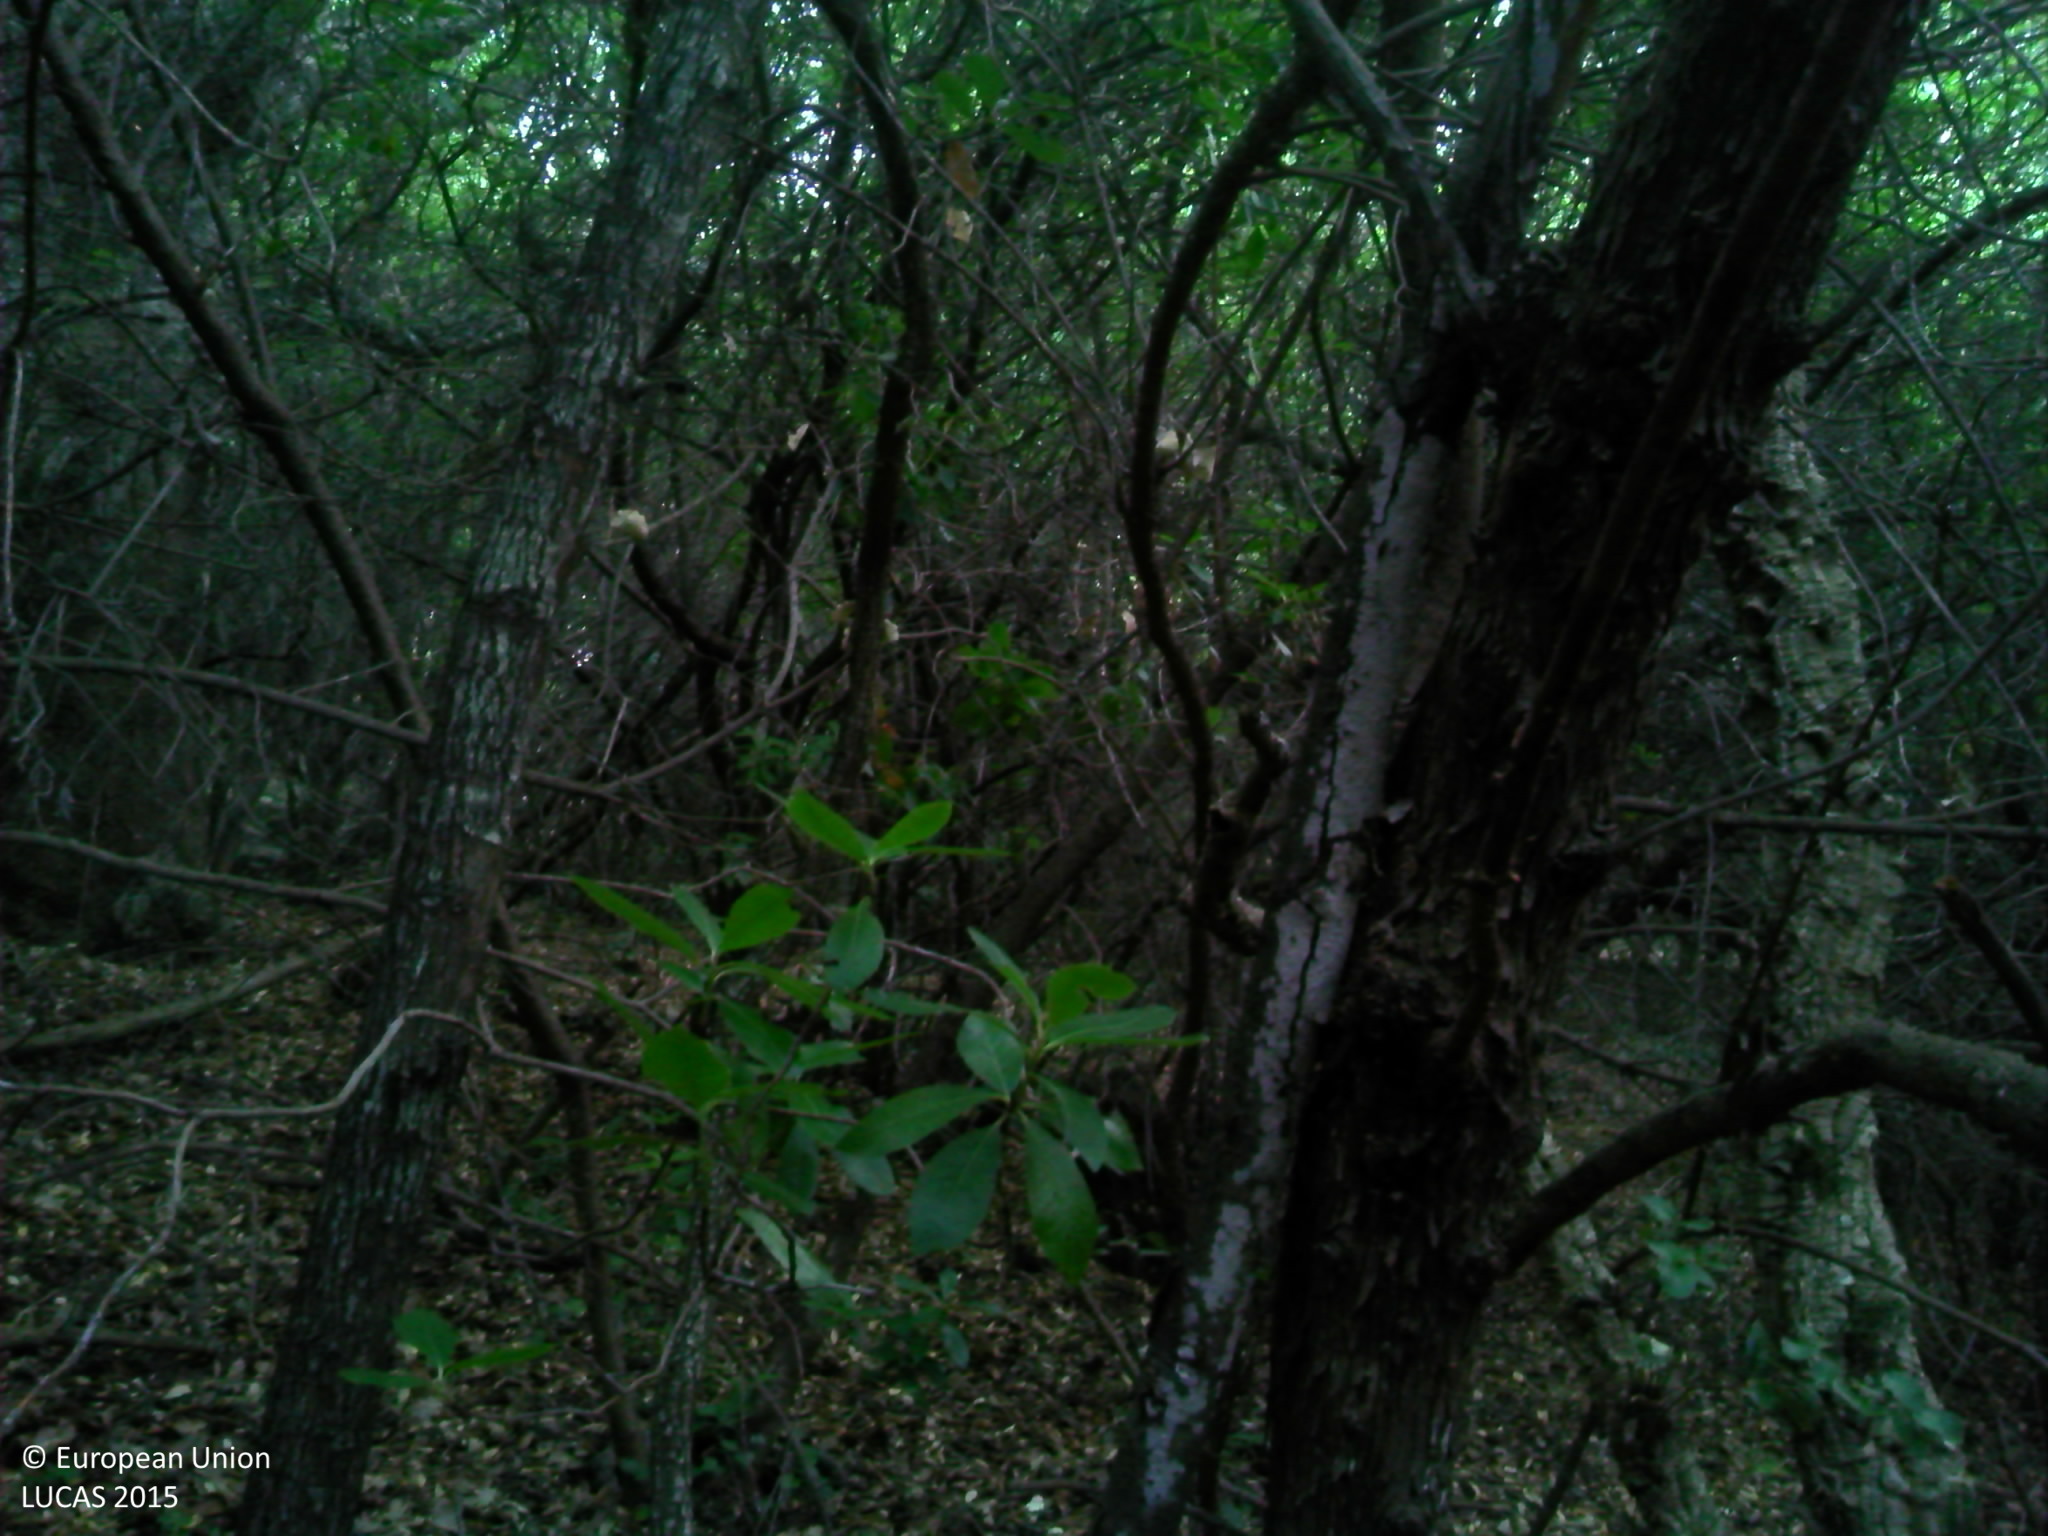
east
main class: Woodland
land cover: Broadleaved woodland
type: broadleaved evergreen forest
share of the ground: > 75 %
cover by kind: broadleaved forest trees 80 %, shrubs 20 %
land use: Semi-natural and natural areas not in use
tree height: > 5 m
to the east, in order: Broadleaved woodland; Paved roads, cycling and walking lanes; Broadleaved woodland; Tracks; Broadleaved woodland; Tracks; Broadleaved woodland
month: July
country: FR
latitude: 43.2732
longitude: 6.3006
